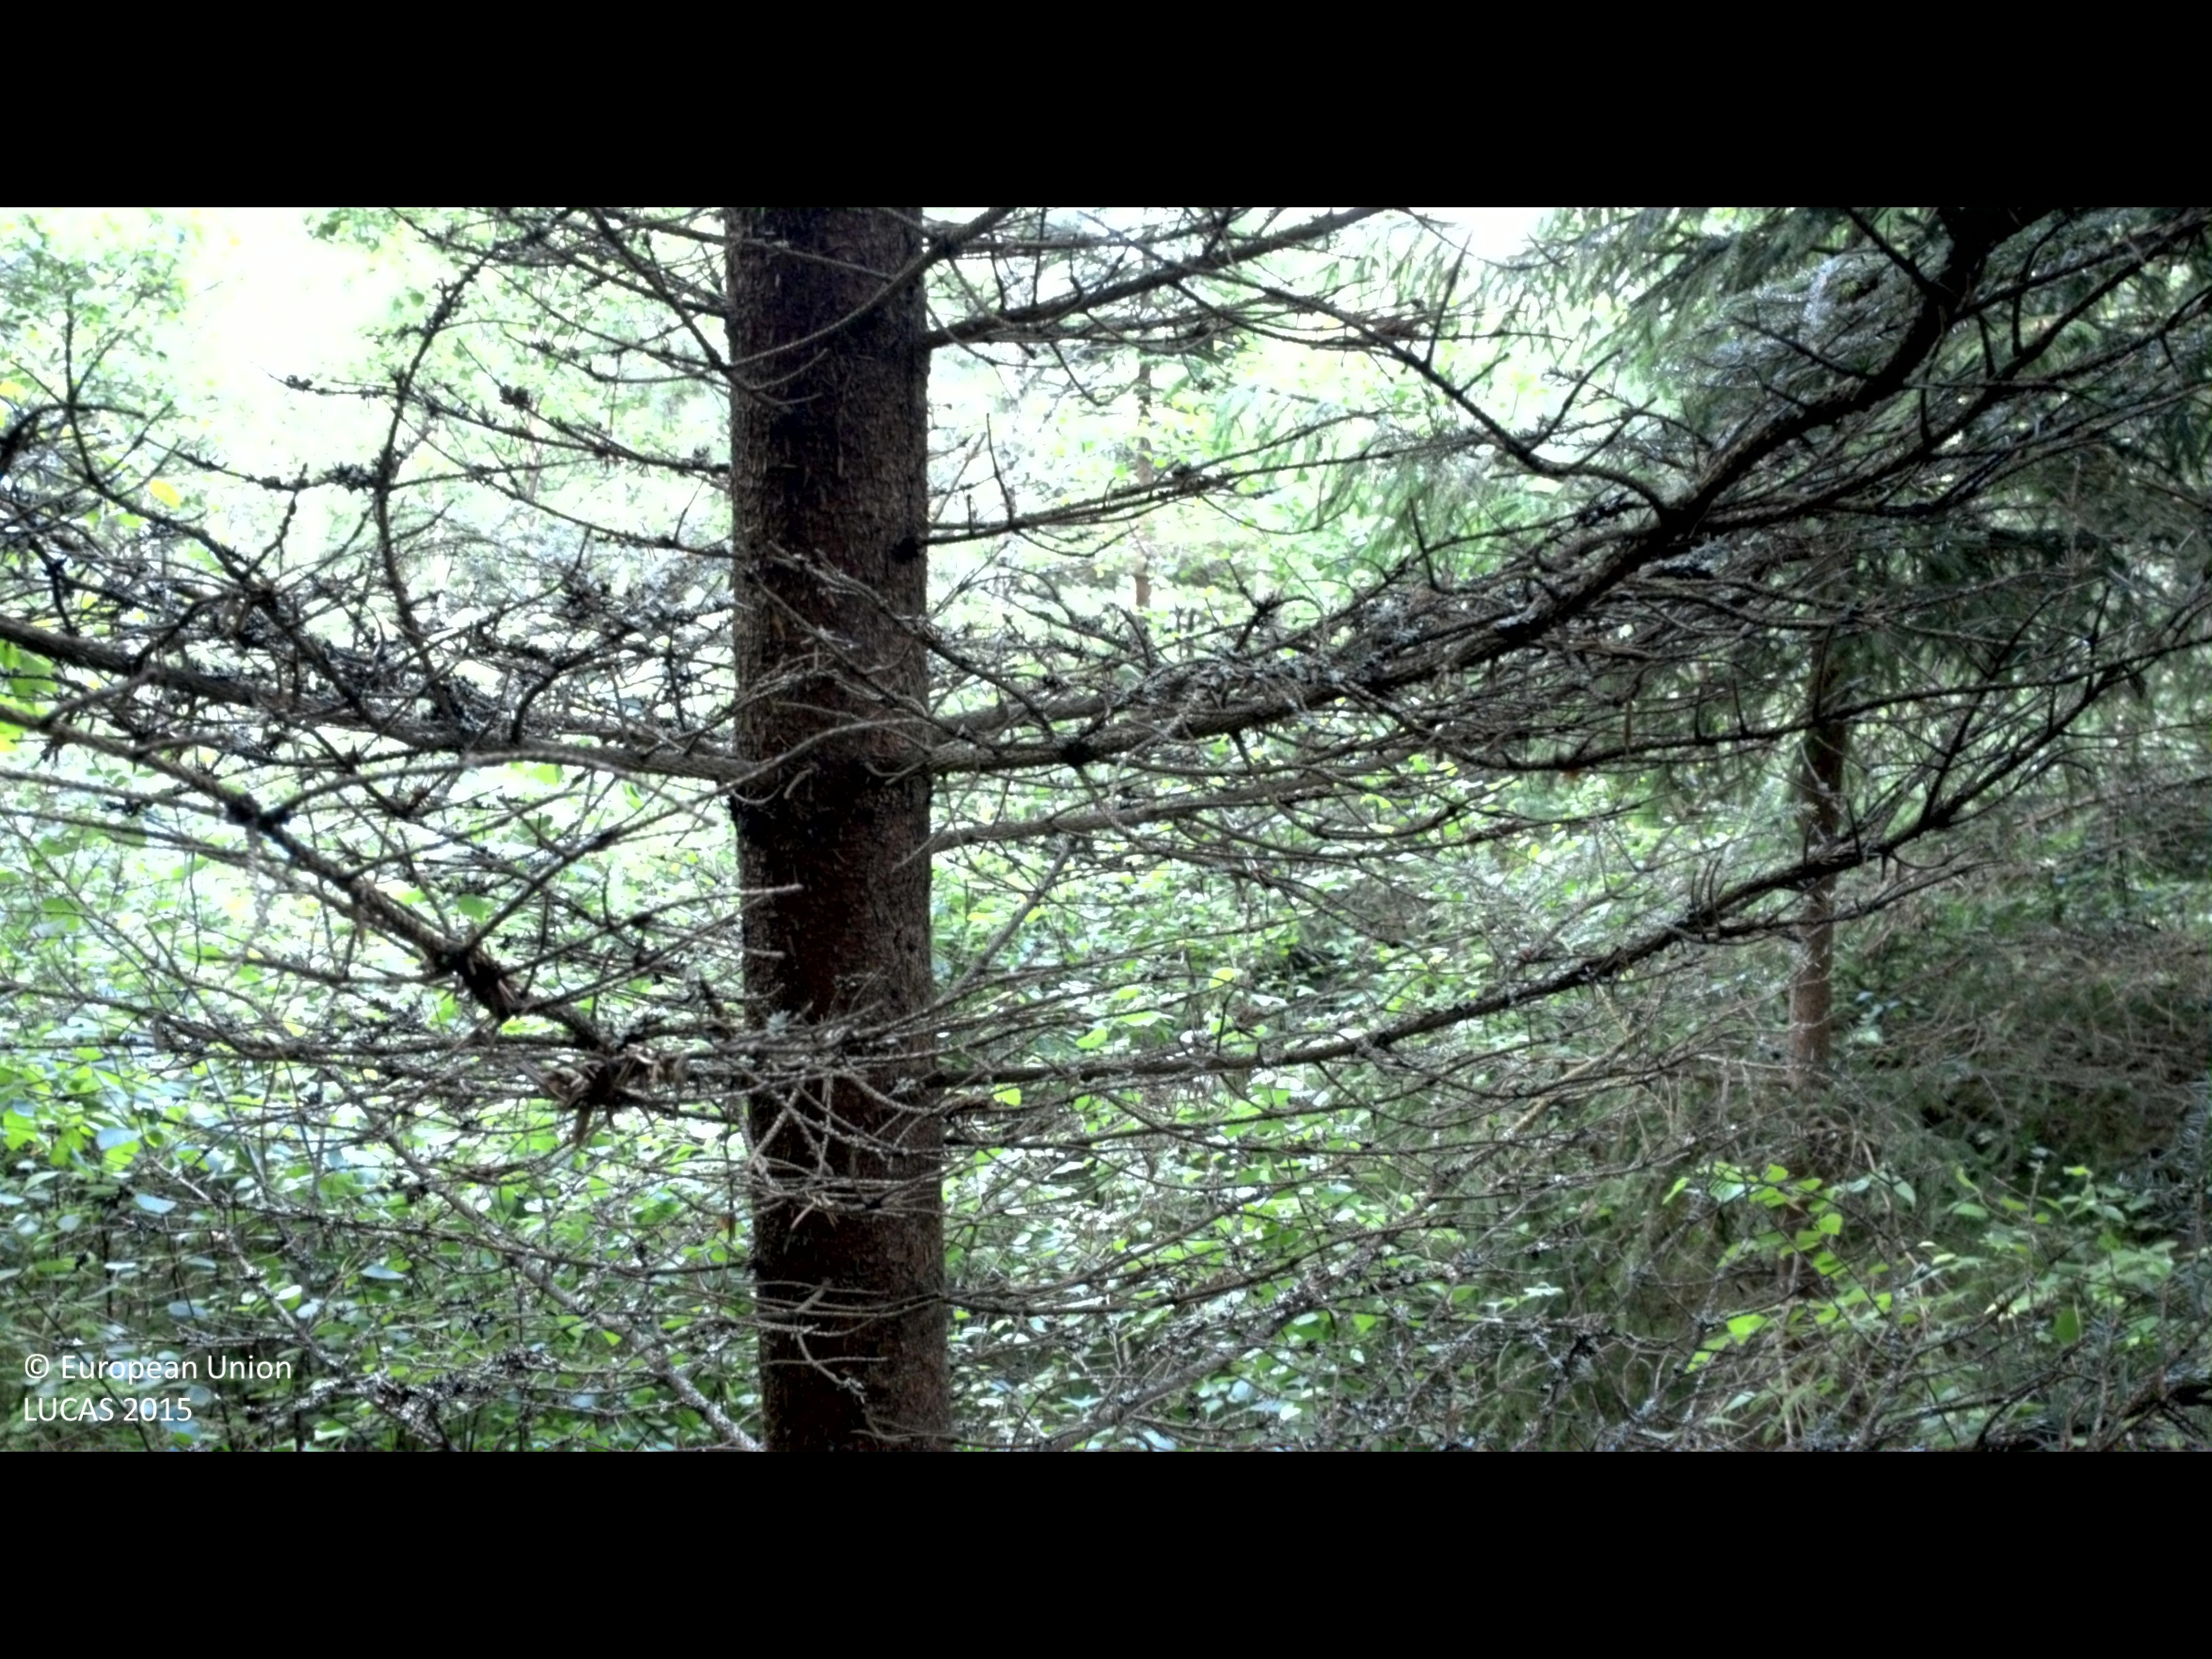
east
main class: Woodland
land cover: Spruce dominated mixed woodland
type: boreal forest
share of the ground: > 75 %
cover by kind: coniferous forest trees 60 %, broadleaved forest trees 20 %, shrubs 20 %
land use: Forestry
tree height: > 5 m
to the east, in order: Spruce dominated mixed woodland; Ditches and canals; Spruce dominated mixed woodland; Ditches and canals; Other mixed woodland; Ditches and canals; Spruce dominated mixed woodland; Grass margins; Paved roads, cycling and walking lanes; Grass margins; Electric lines; Inland marshes; Inland fresh water bodies; Pine dominated coniferous woodland
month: July
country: SE
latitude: 56.4911
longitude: 13.8138
